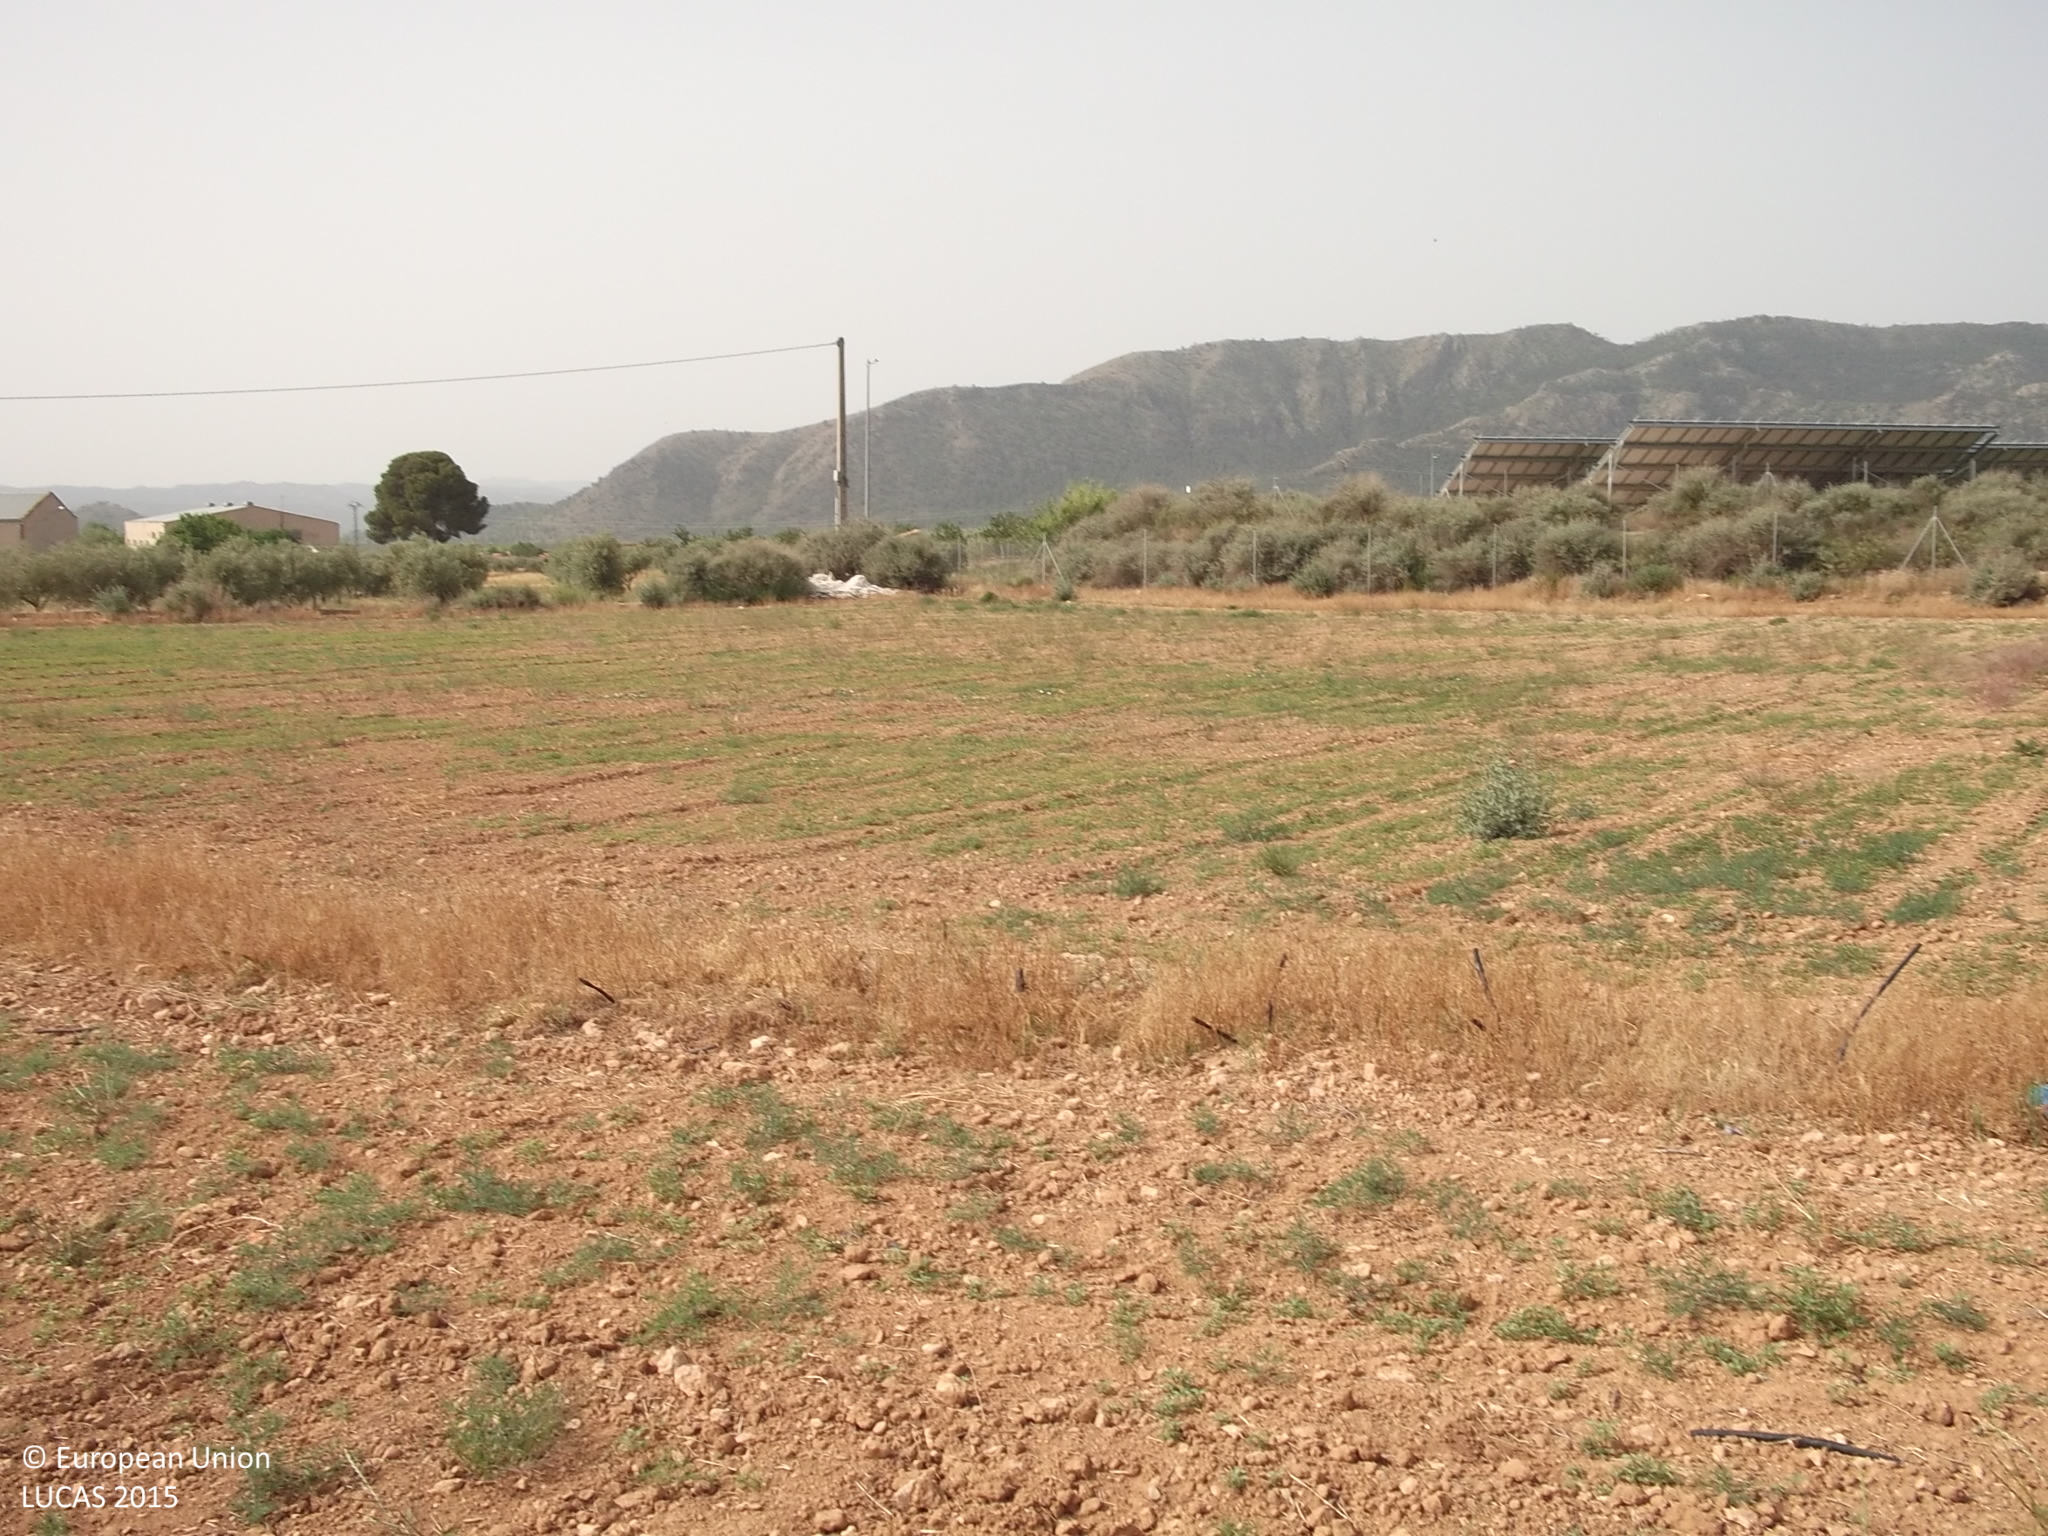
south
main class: Grassland
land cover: Spontaneously vegetated surfaces
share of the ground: 25 - 50 %
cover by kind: unconsolidated bare surface 70 %, herbaceous plants 30 %
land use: Fallow land
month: May
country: ES
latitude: 38.4206
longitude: -1.6404
